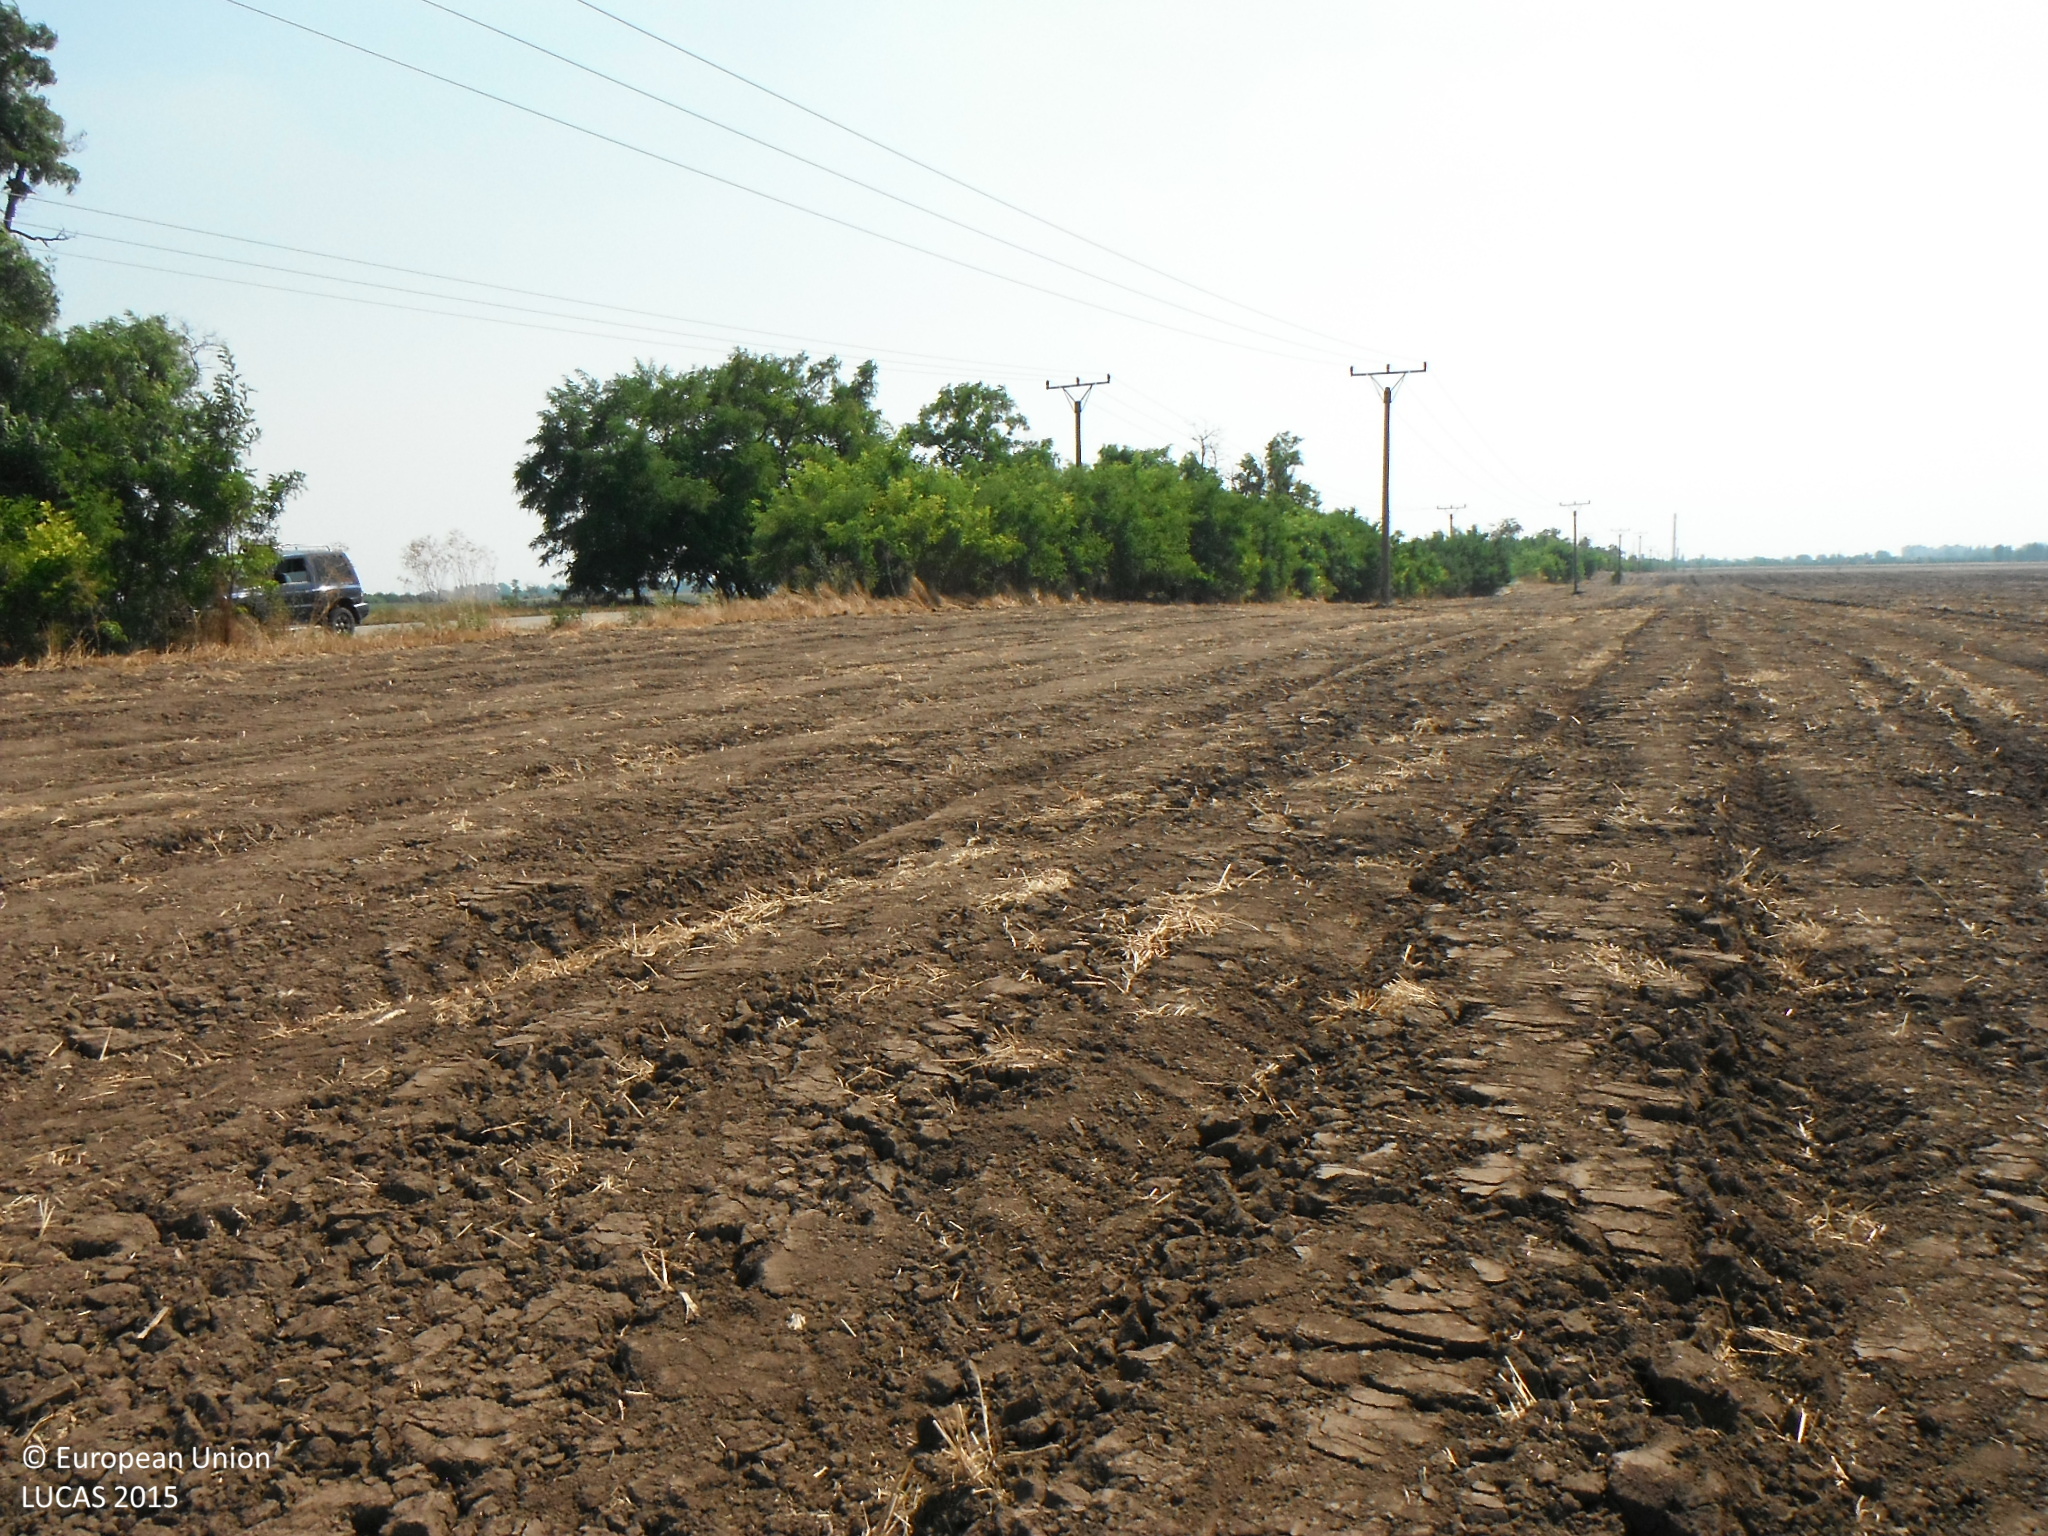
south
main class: Cropland
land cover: Common wheat
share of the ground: < 10 %
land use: Agriculture (excluding fallow land and kitchen gardens)
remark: Harvested field
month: August
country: SK
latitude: 48.0079
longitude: 18.2038
